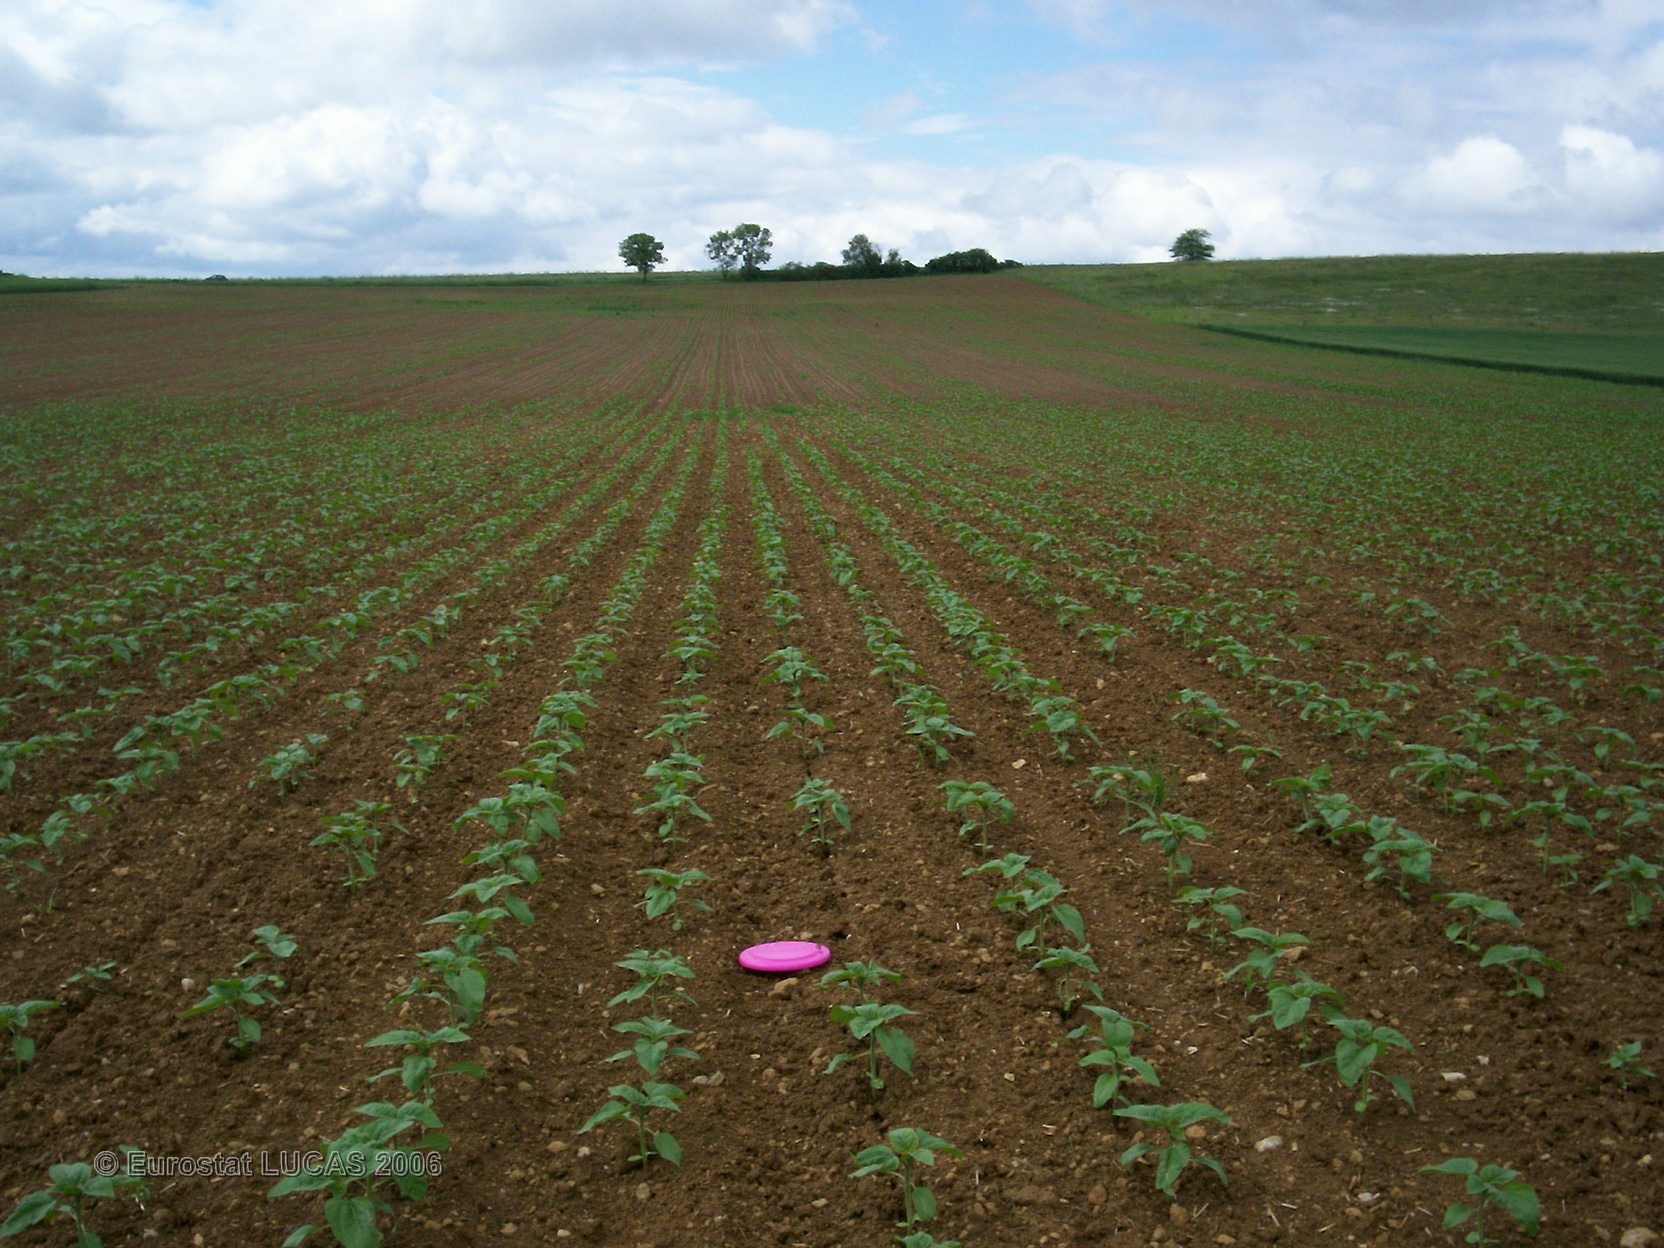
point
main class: Cropland
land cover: Sunflower
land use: Agriculture (excluding fallow land and kitchen gardens)
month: May
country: FR
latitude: 48.2687
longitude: 4.5413
